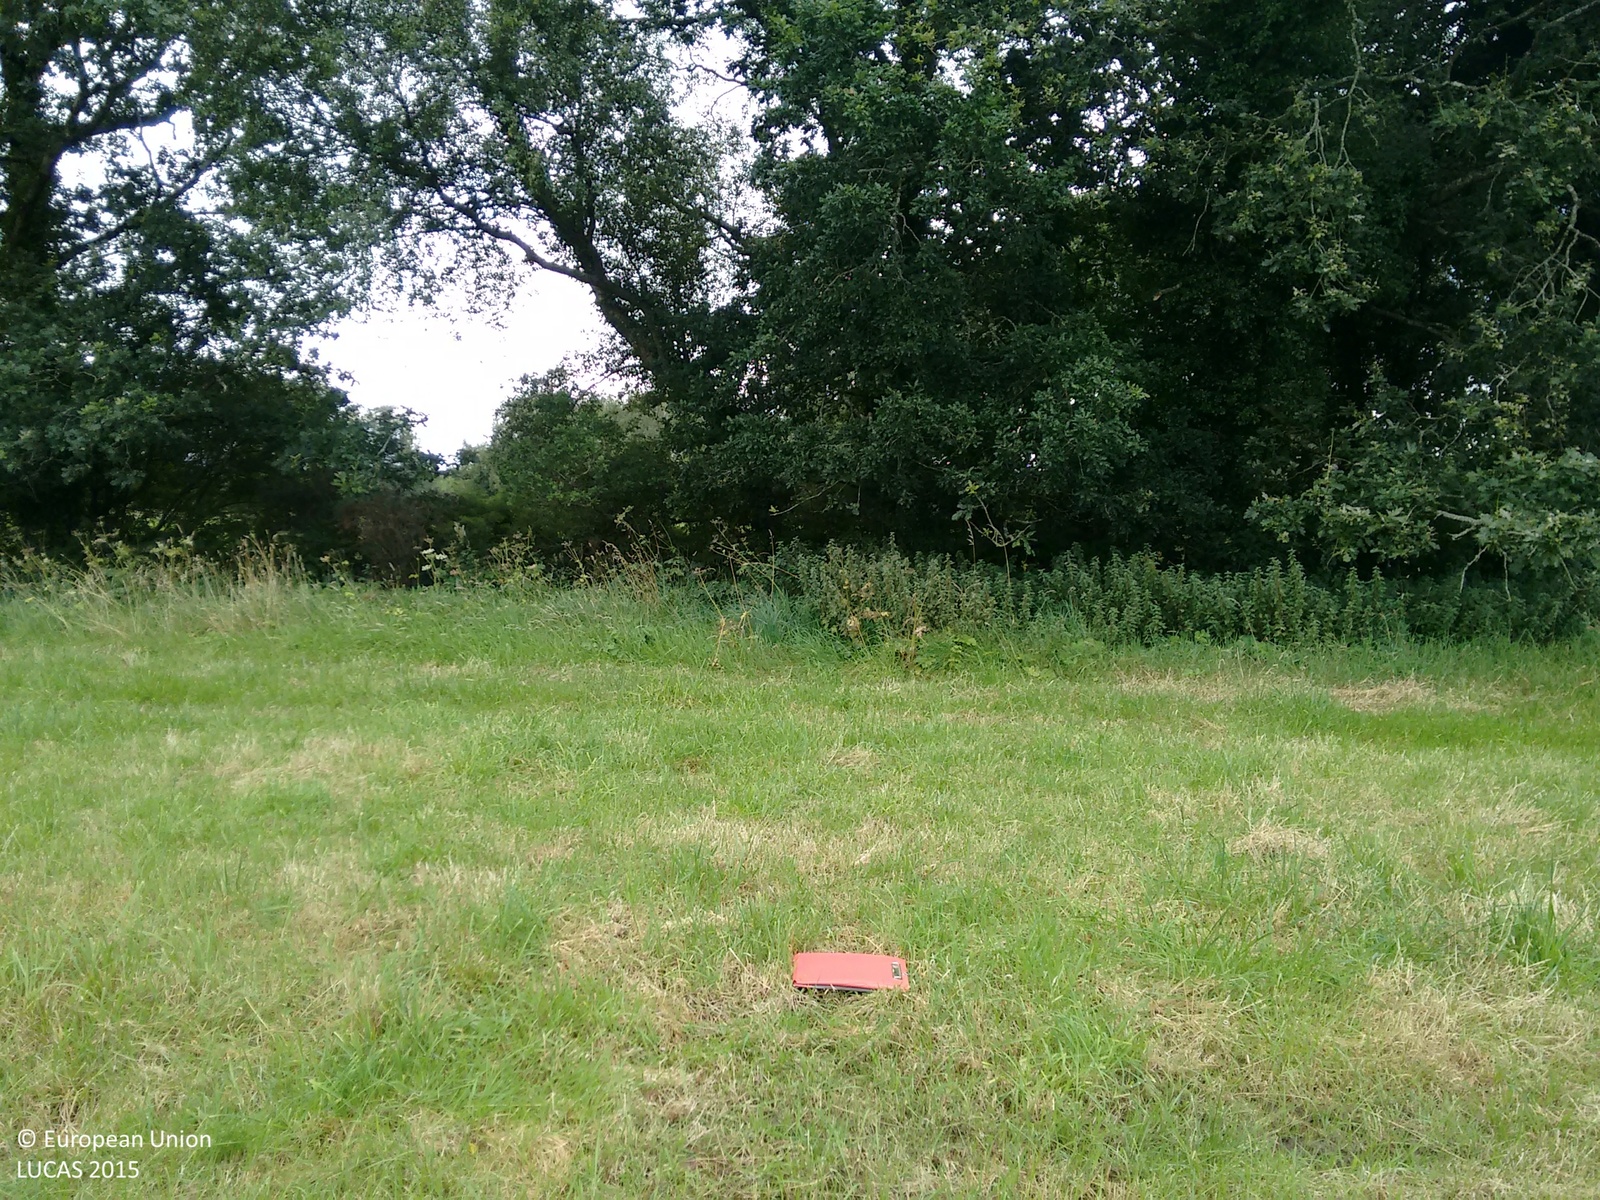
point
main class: Grassland
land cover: Grassland without tree/shrub cover
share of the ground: > 75 %
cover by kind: herbaceous plants 95 %, unconsolidated bare surface 5 %
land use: Agriculture (excluding fallow land and kitchen gardens)
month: August
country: IE
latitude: 52.6028
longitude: -8.2732
